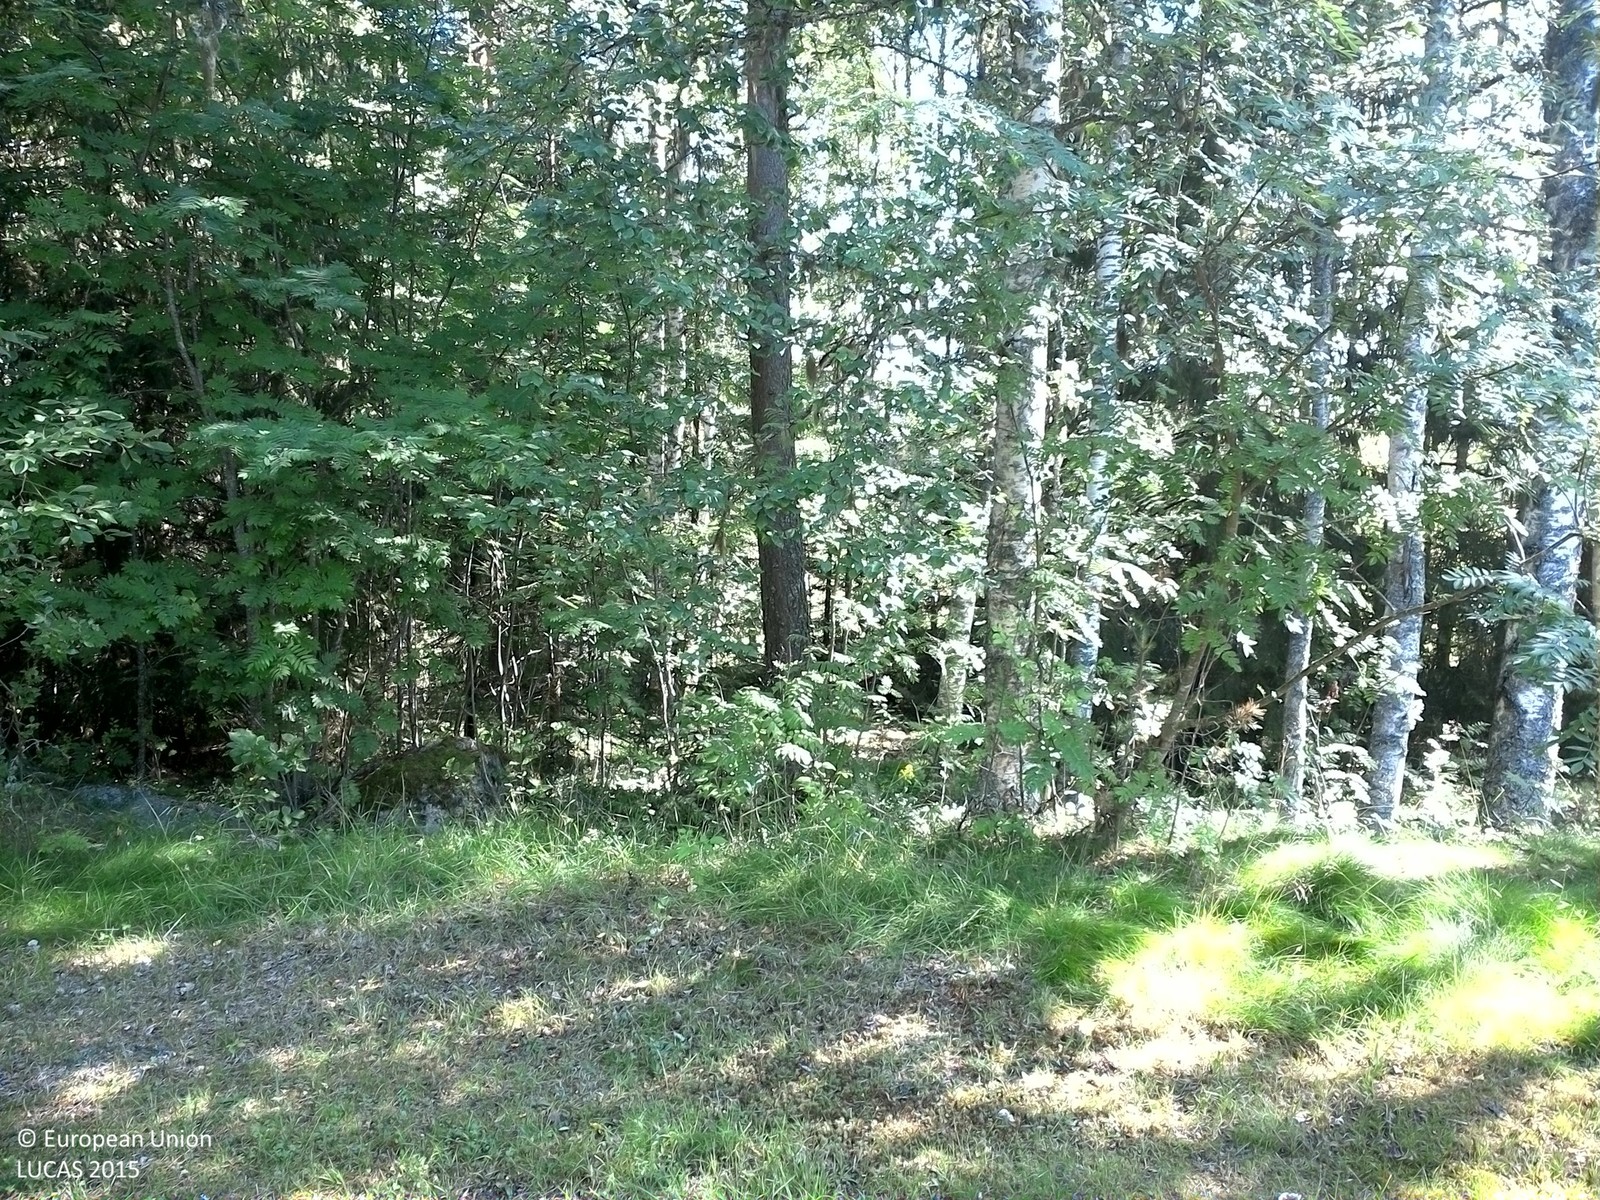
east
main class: Grassland
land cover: Grassland without tree/shrub cover
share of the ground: > 75 %
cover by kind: herbaceous plants 75 %, lichens and mosses 25 %
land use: Residential
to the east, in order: Grassland without tree/shrub cover; Spruce dominated mixed woodland; Artificial constructions in urban areas; Broadleaved woodland; Grassland without tree/shrub cover; Electric lines; Grassland with sparse tree/shrub cover; Ditches and canals; Grassland with sparse tree/shrub cover
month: August
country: SE
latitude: 63.7977
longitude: 16.4070
